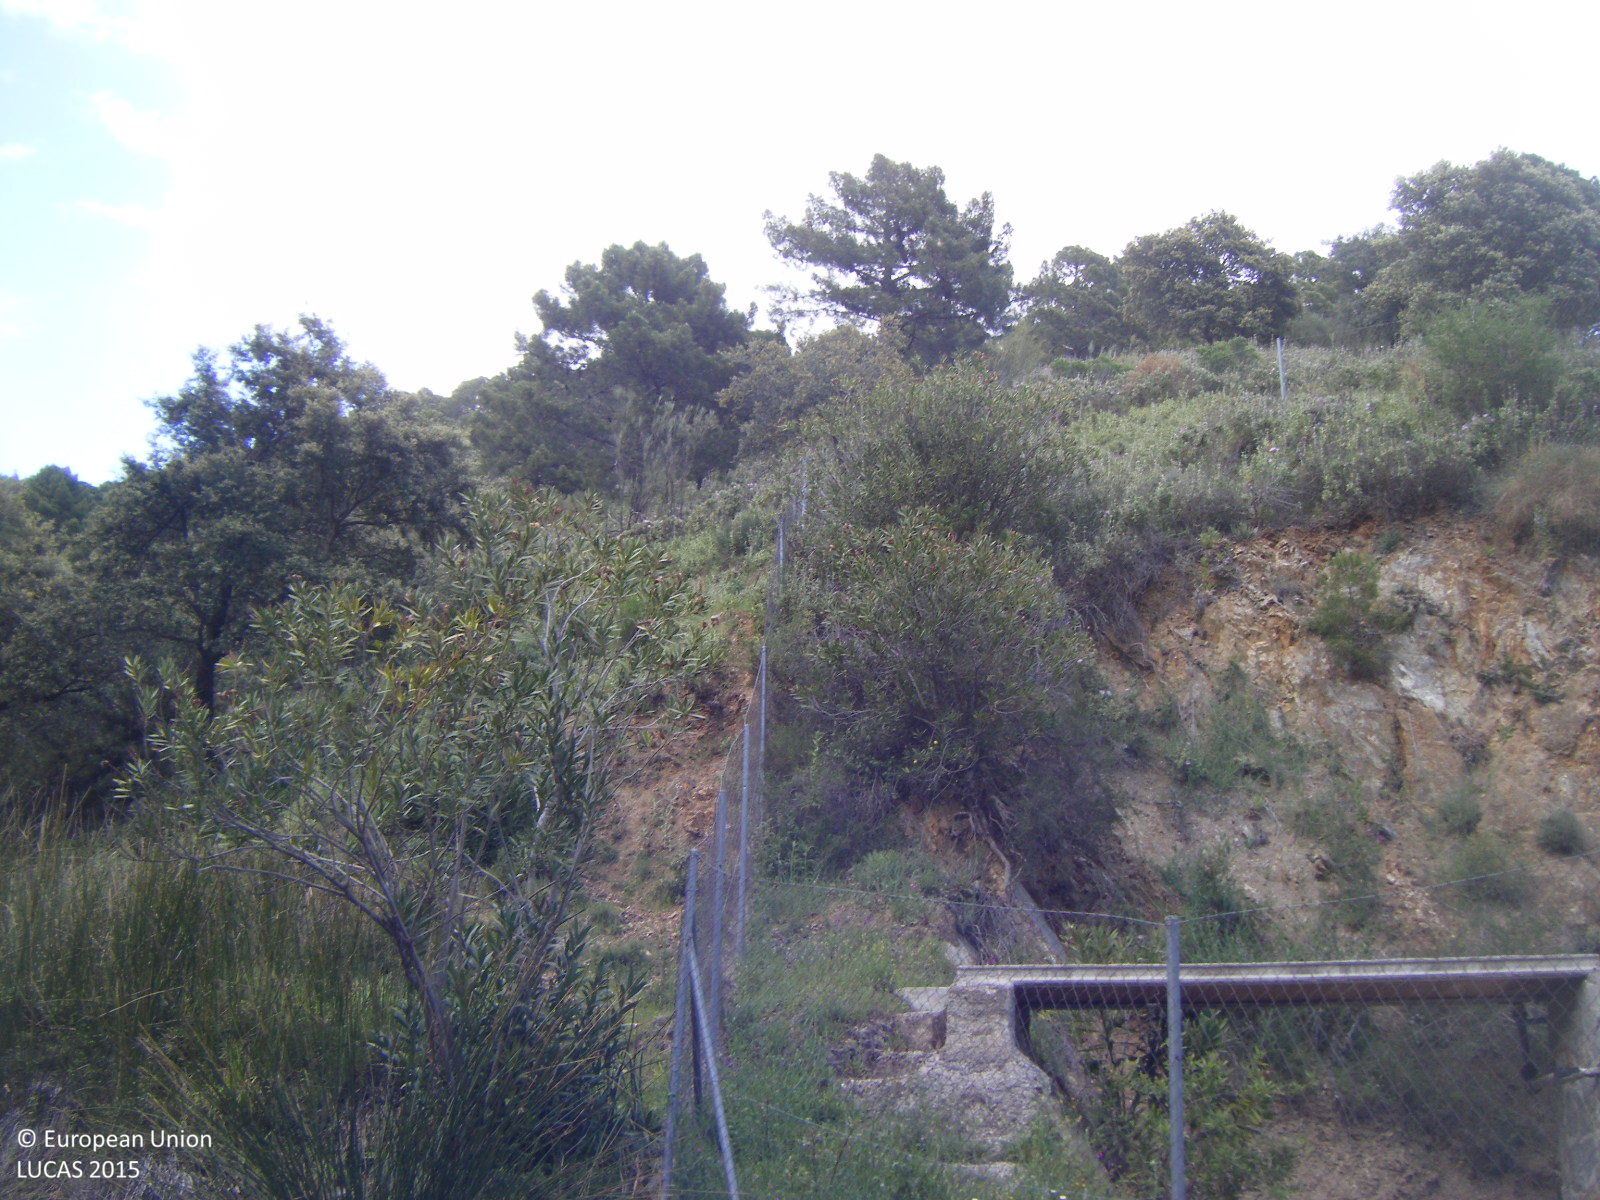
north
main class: Woodland
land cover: Pine dominated coniferous woodland
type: coniferous forest of the mediterranean region
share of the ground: 25 - 50 %
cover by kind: coniferous forest trees 40 %, shrubs 40 %, herbaceous plants 20 %
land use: Forestry
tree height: > 5 m
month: April
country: ES
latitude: 36.8685
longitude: -4.0216
